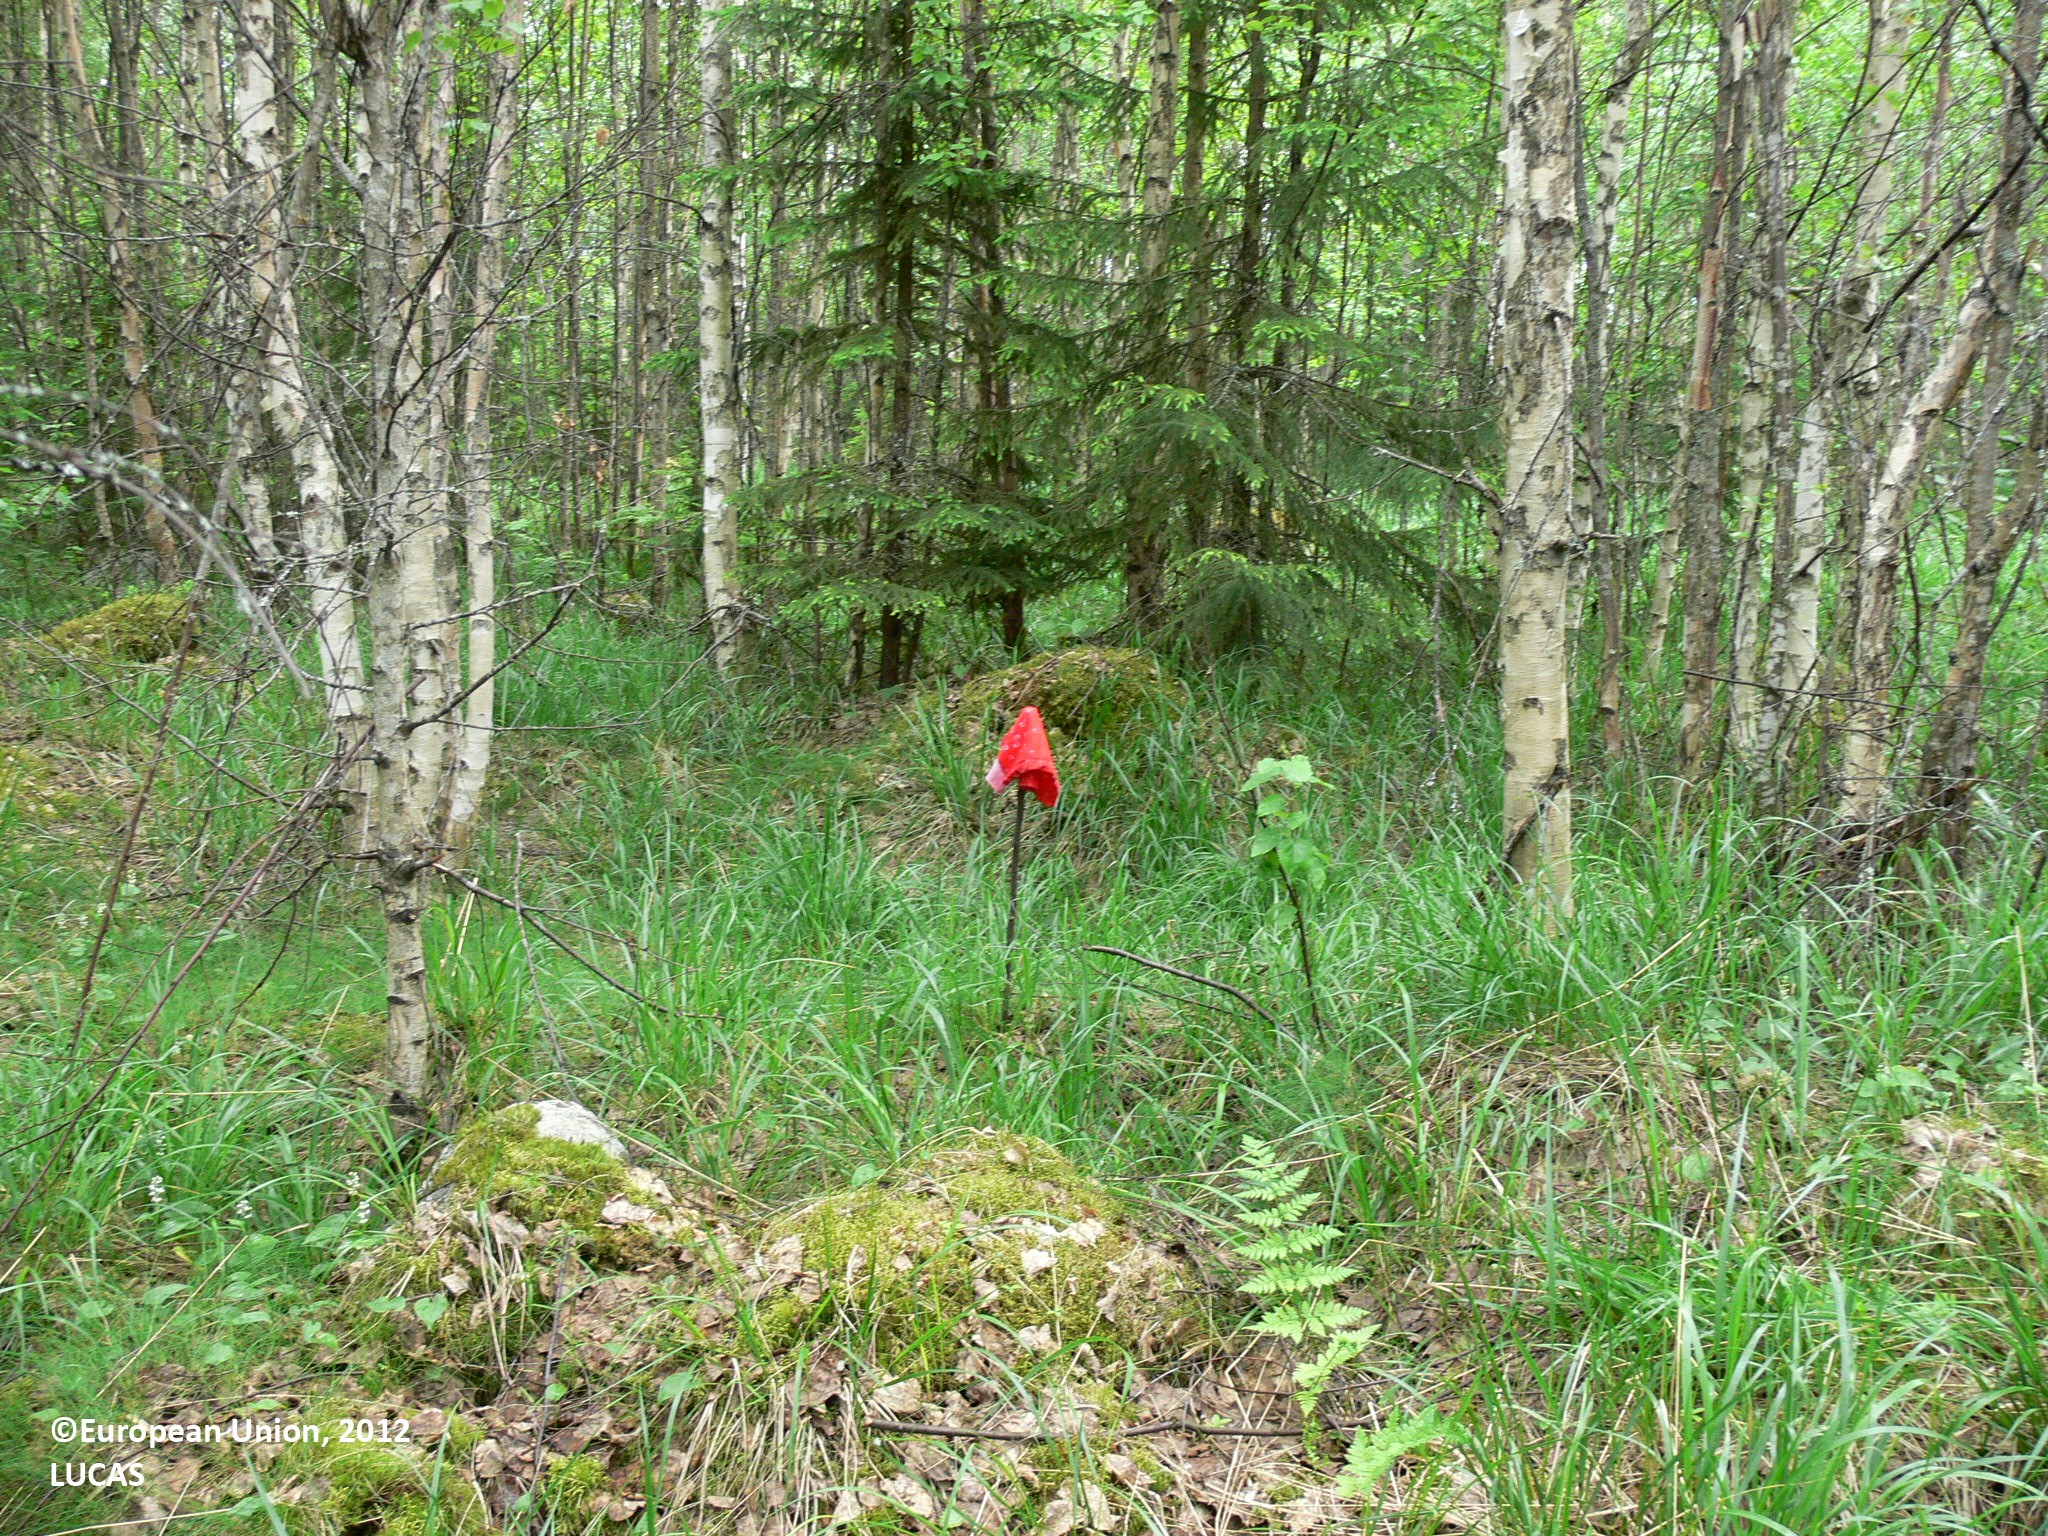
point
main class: Woodland
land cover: Spruce dominated mixed woodland
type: boreal forest
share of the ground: > 75 %
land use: Forestry
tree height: > 5 m
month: June
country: FI
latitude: 62.9835
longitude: 29.7598
